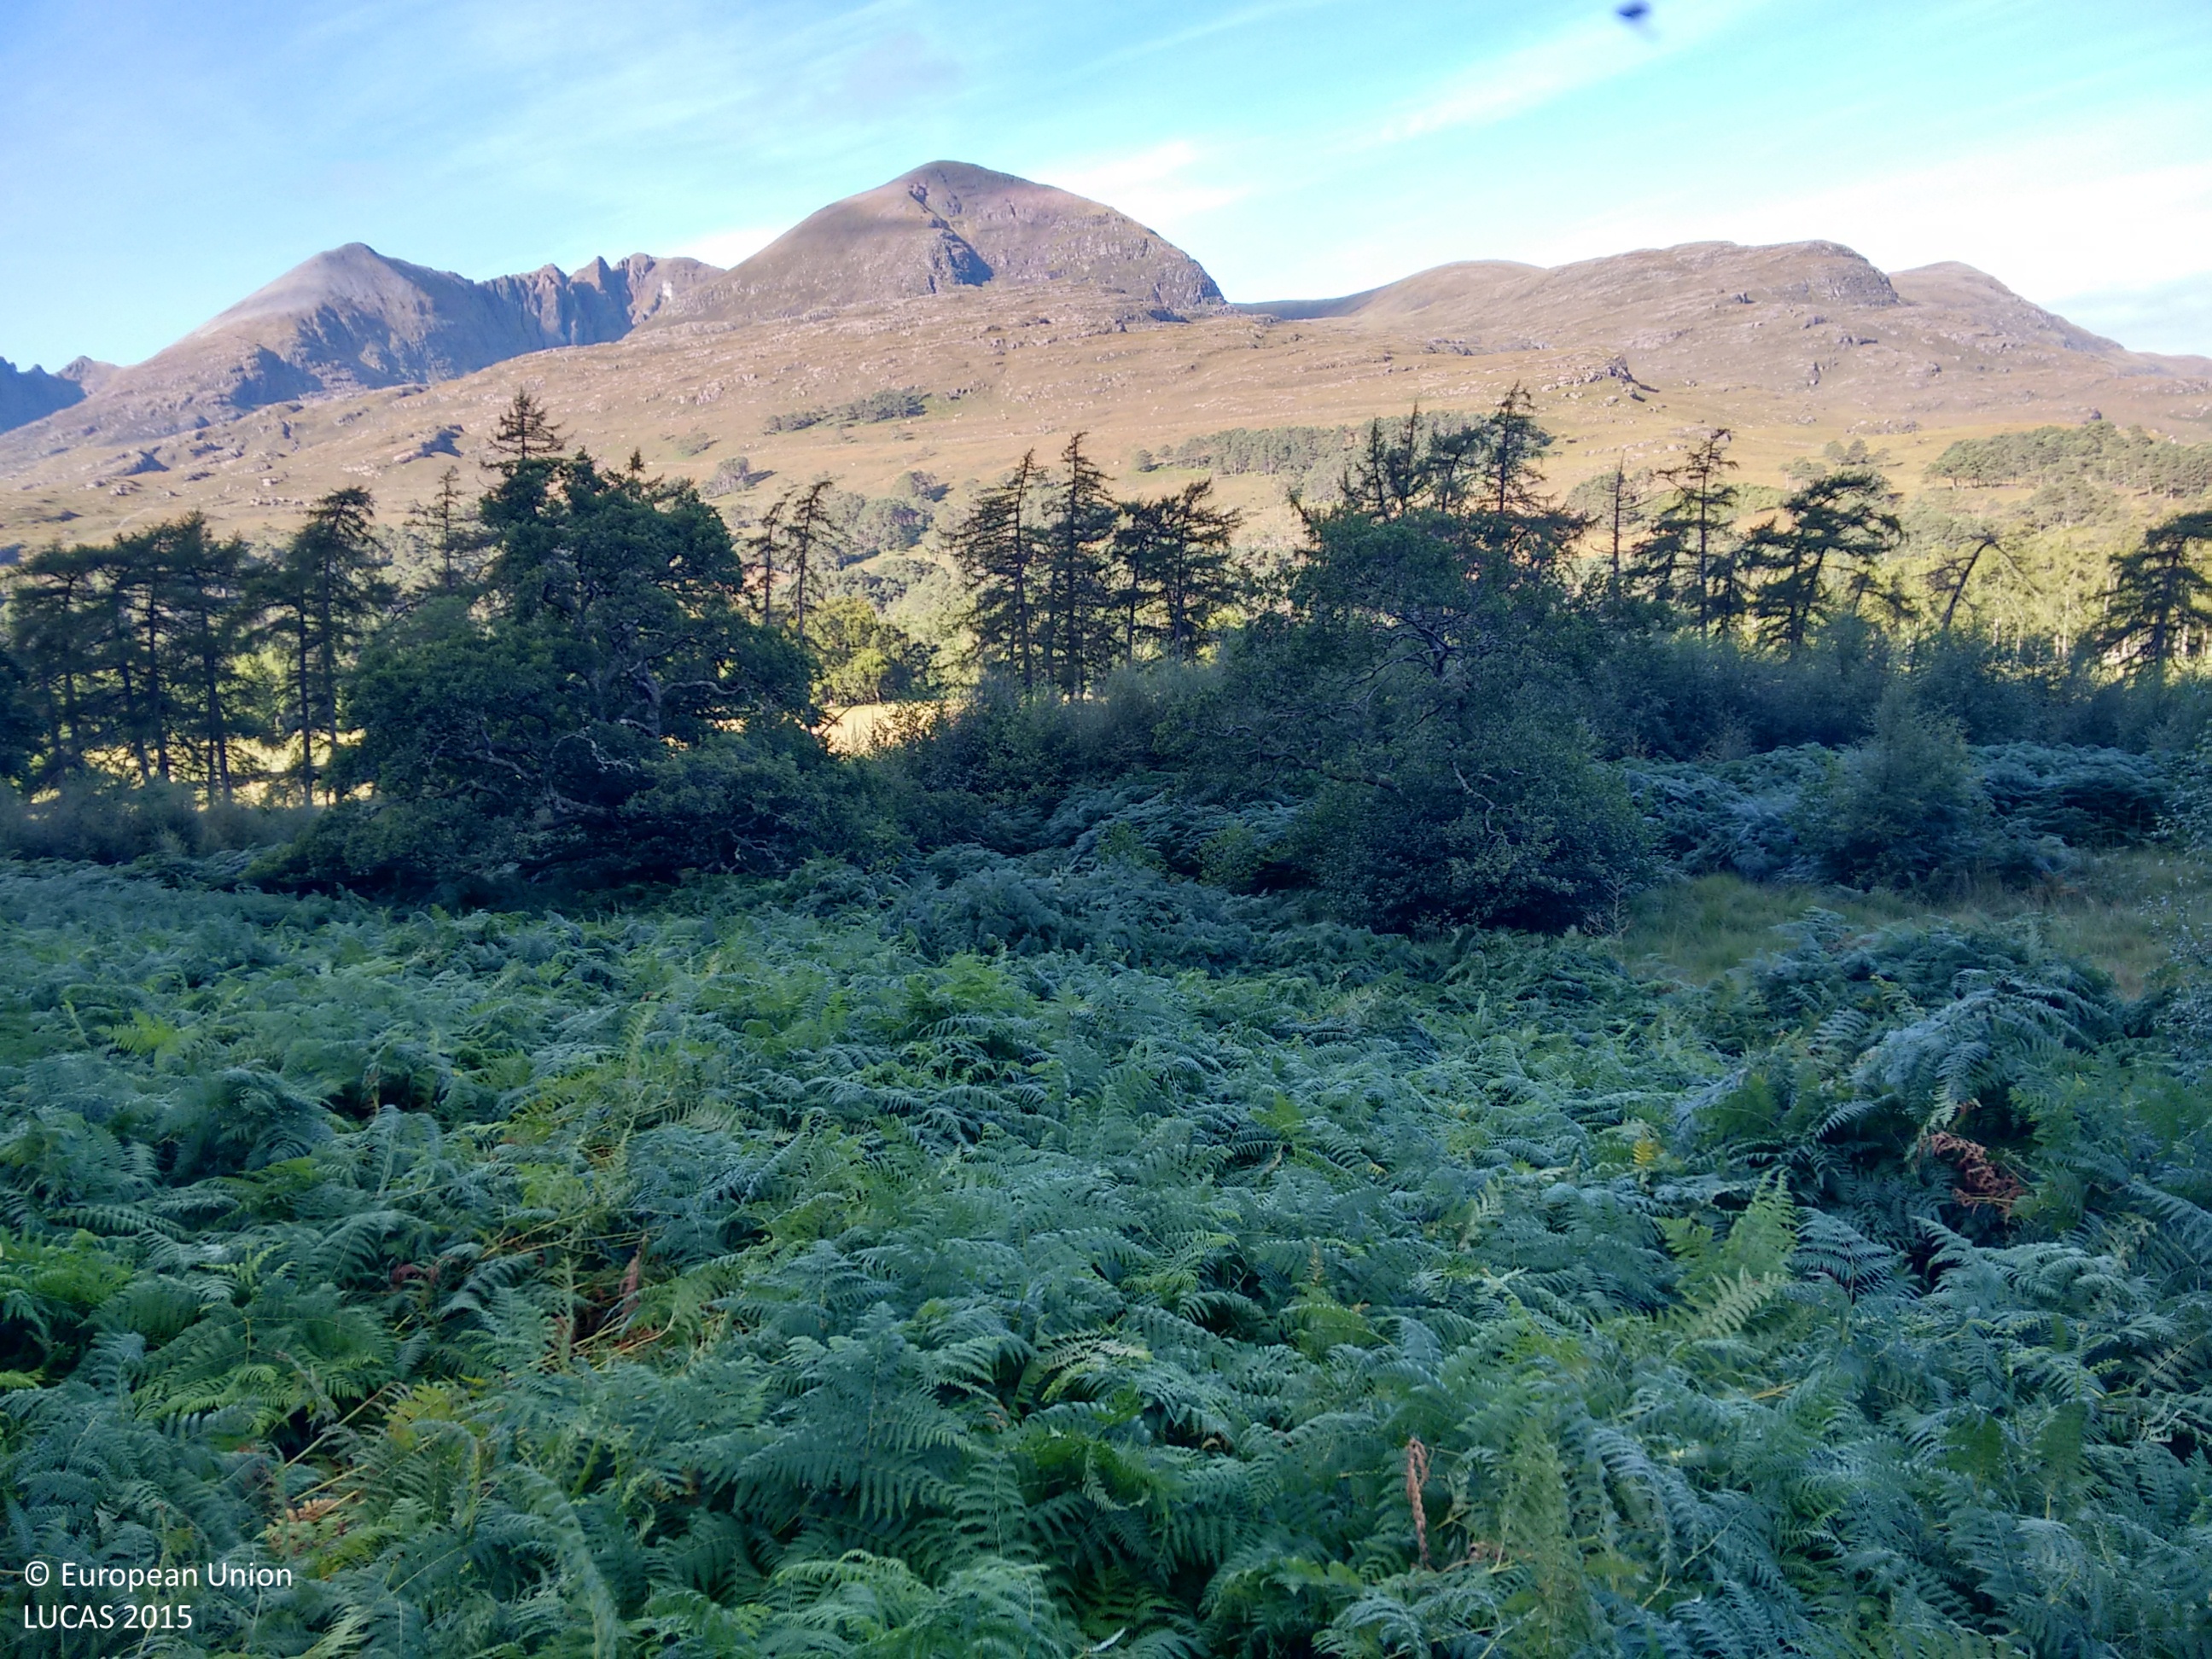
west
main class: Grassland
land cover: Grassland with sparse tree/shrub cover
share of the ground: > 75 %
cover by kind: herbaceous plants 85 %, shrubs 10 %, broadleaved forest trees 5 %
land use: Forestry
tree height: > 5 m
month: September
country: GB
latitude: 57.8275
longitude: -5.1753
